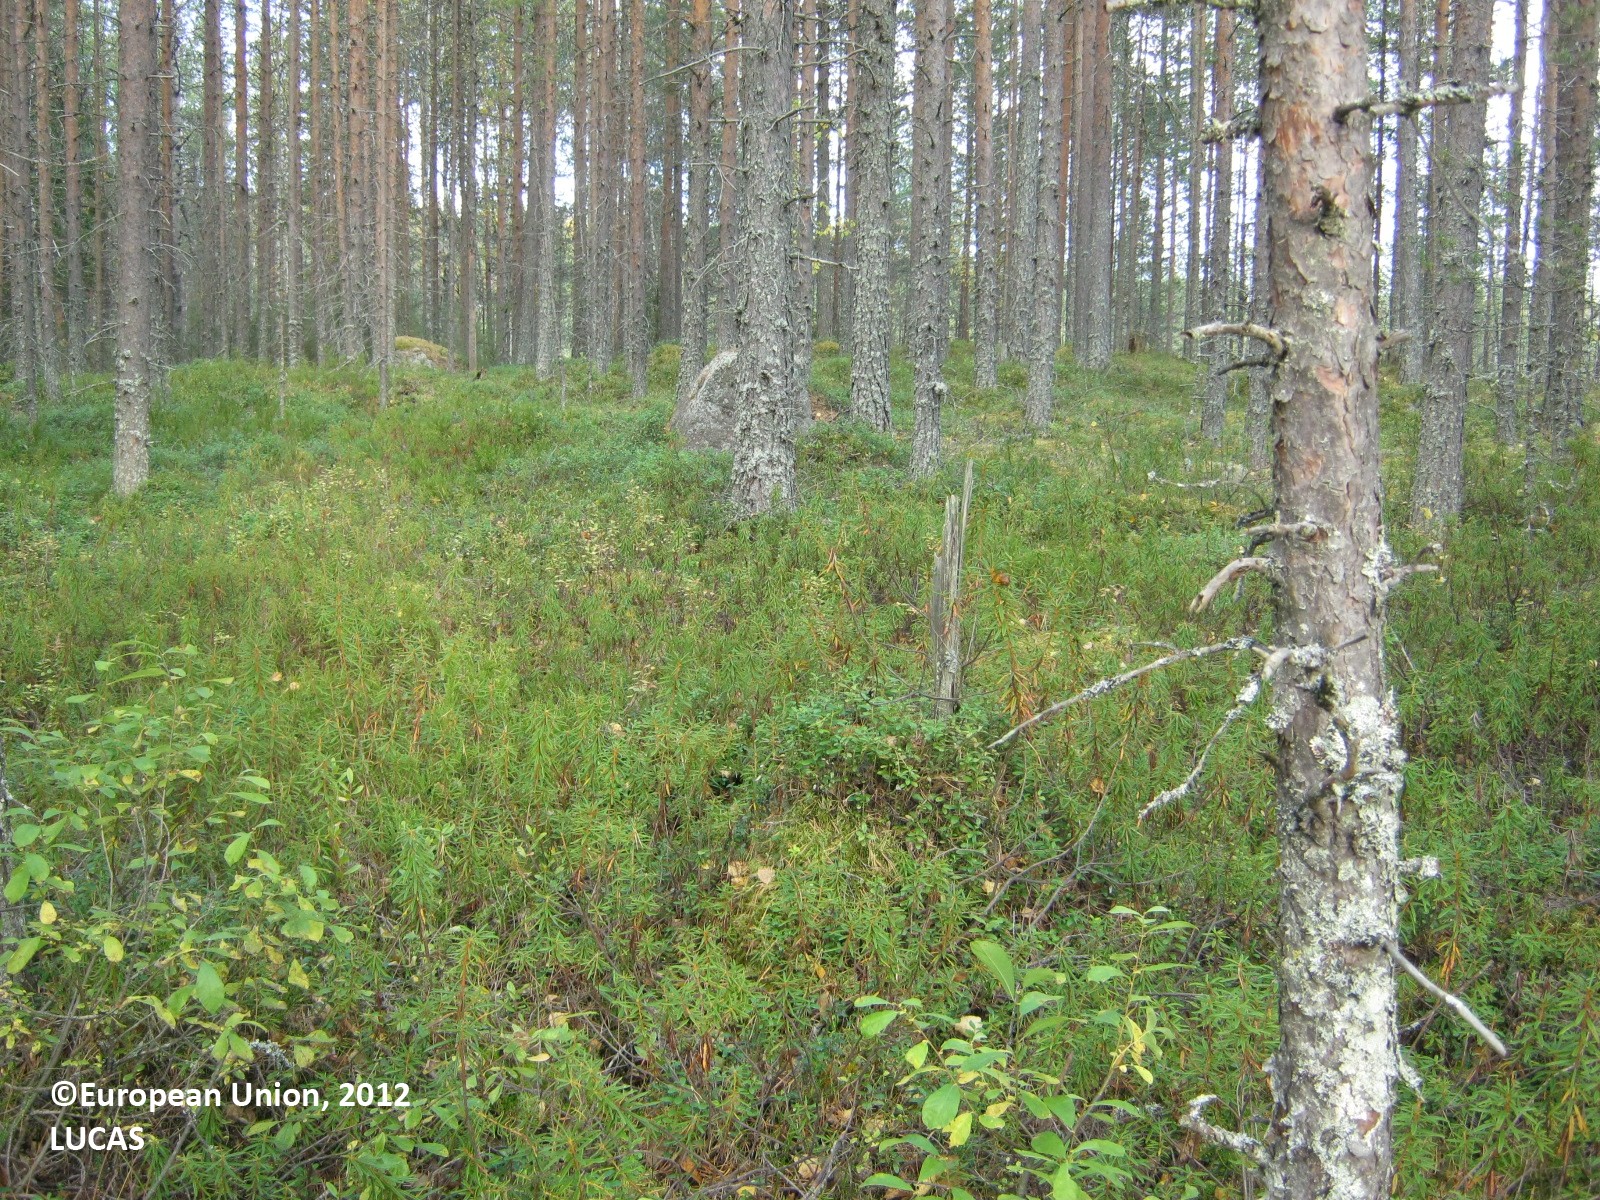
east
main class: Woodland
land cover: Pine dominated coniferous woodland
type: boreal forest
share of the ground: > 75 %
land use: Forestry
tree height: > 5 m
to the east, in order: Pine dominated coniferous woodland; Ditches and canals; Pine dominated coniferous woodland; Shrubland with sparse tree cover; Ditches and canals; Shrubland with sparse tree cover; Ditches and canals; Pine dominated coniferous woodland; Ditches and canals; Broadleaved woodland; Tracks
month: September
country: FI
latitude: 63.4985
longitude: 25.8786
